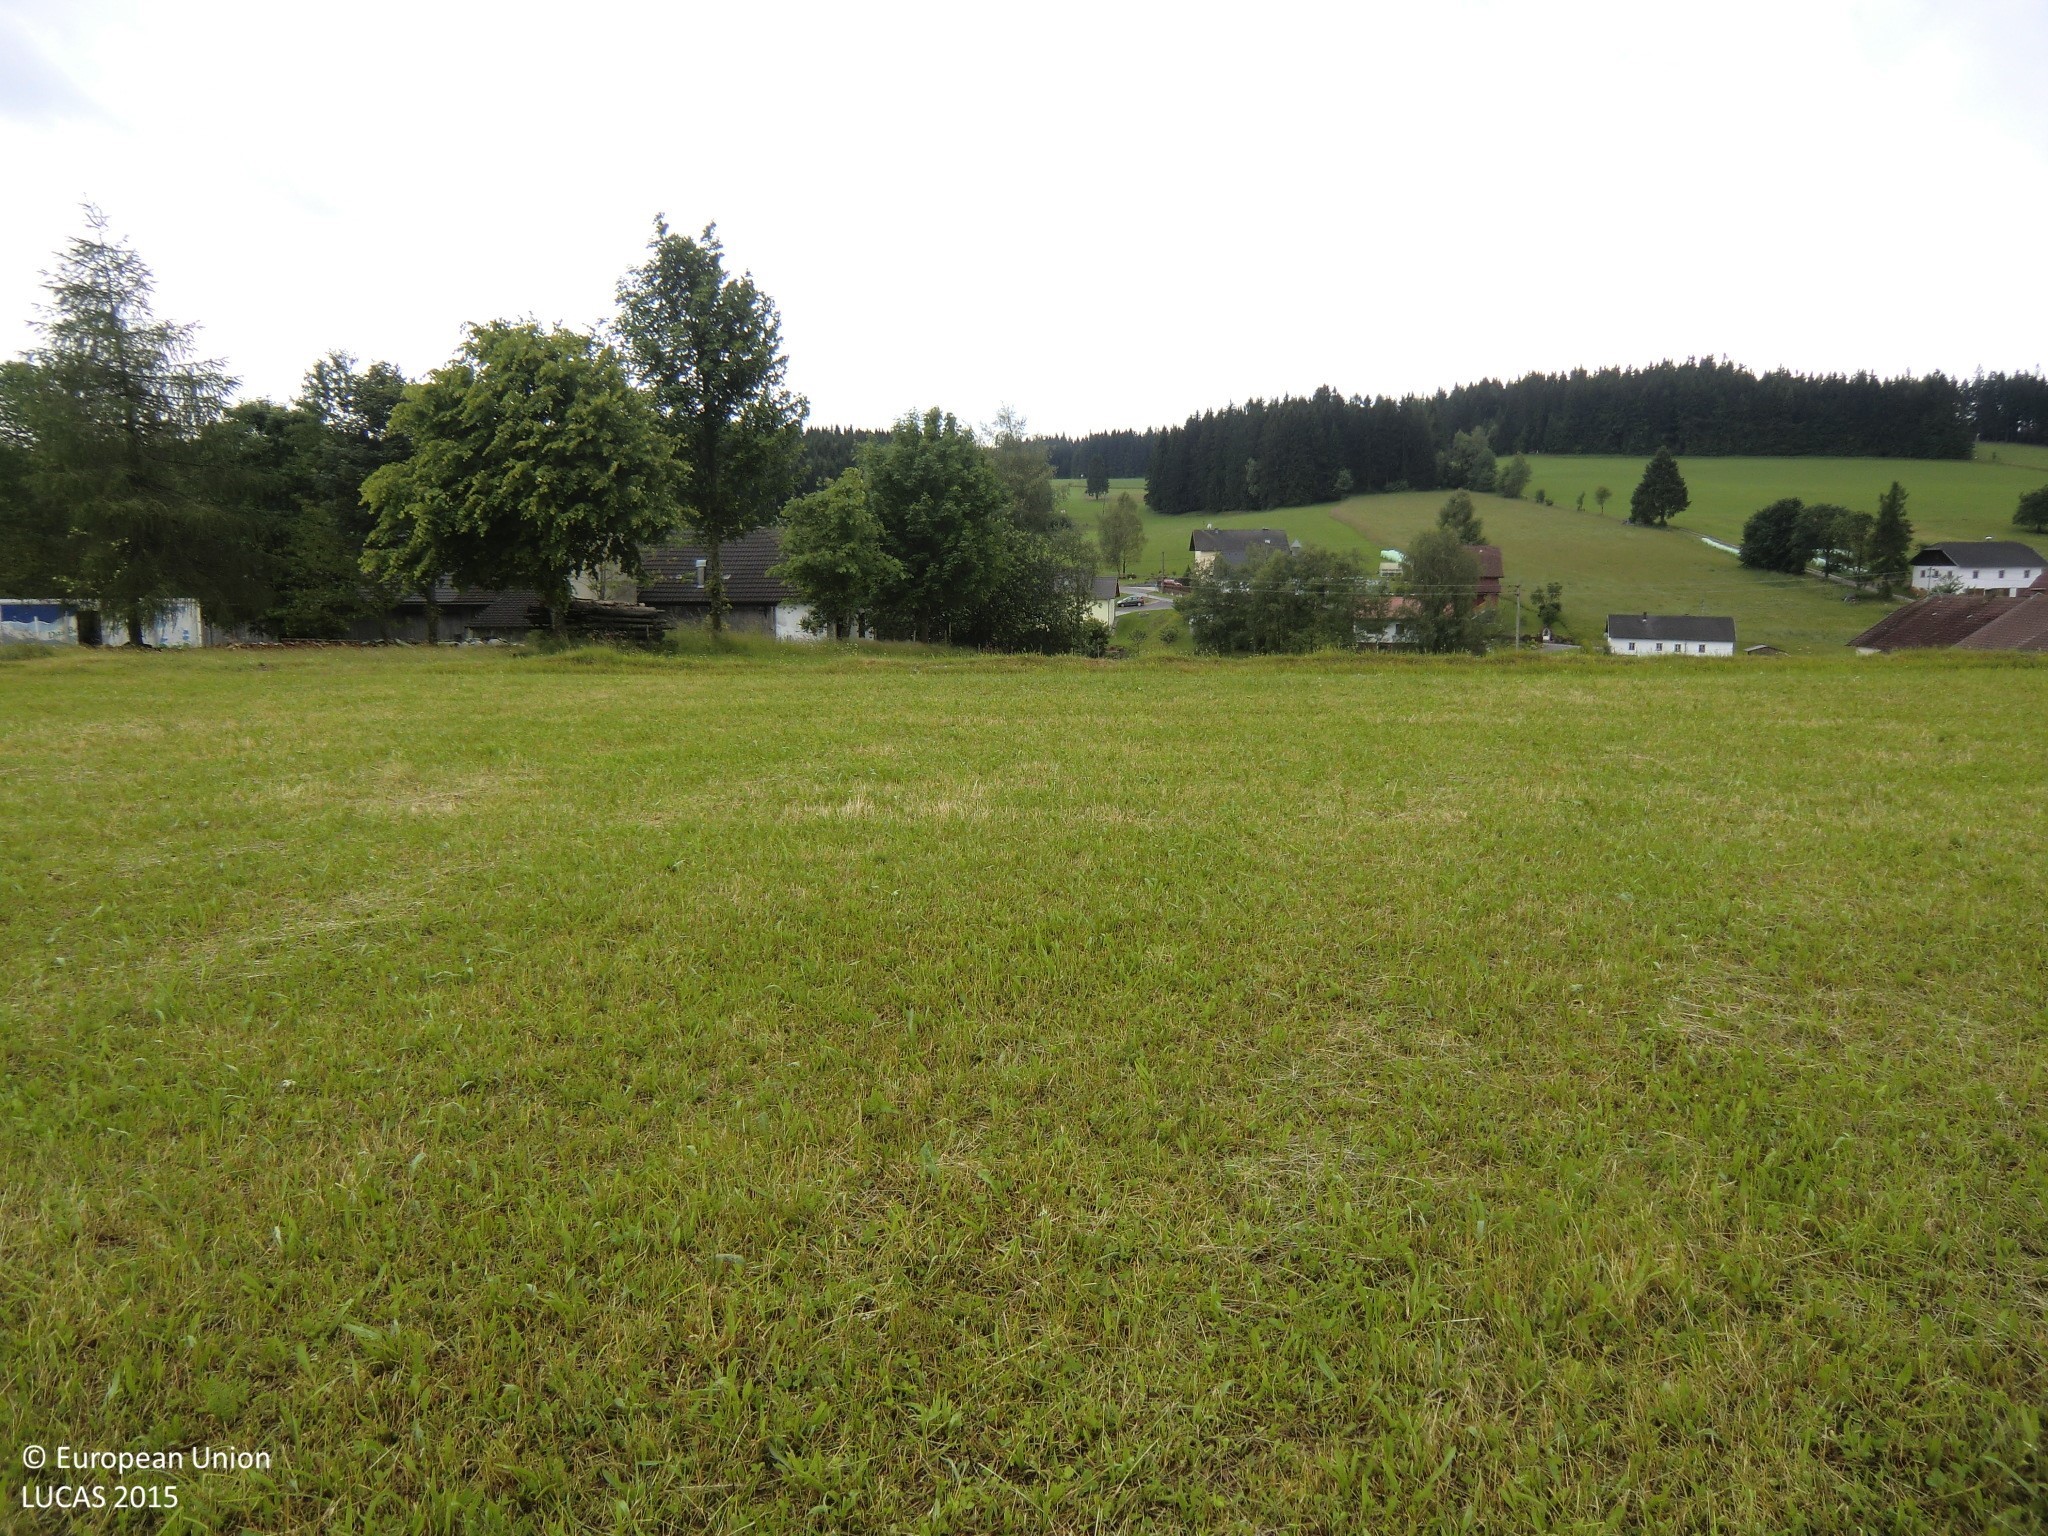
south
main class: Grassland
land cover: Grassland without tree/shrub cover
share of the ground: > 75 %
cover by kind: herbaceous plants 100 %
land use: Agriculture (excluding fallow land and kitchen gardens)
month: June
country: AT
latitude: 48.5435
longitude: 14.5656
